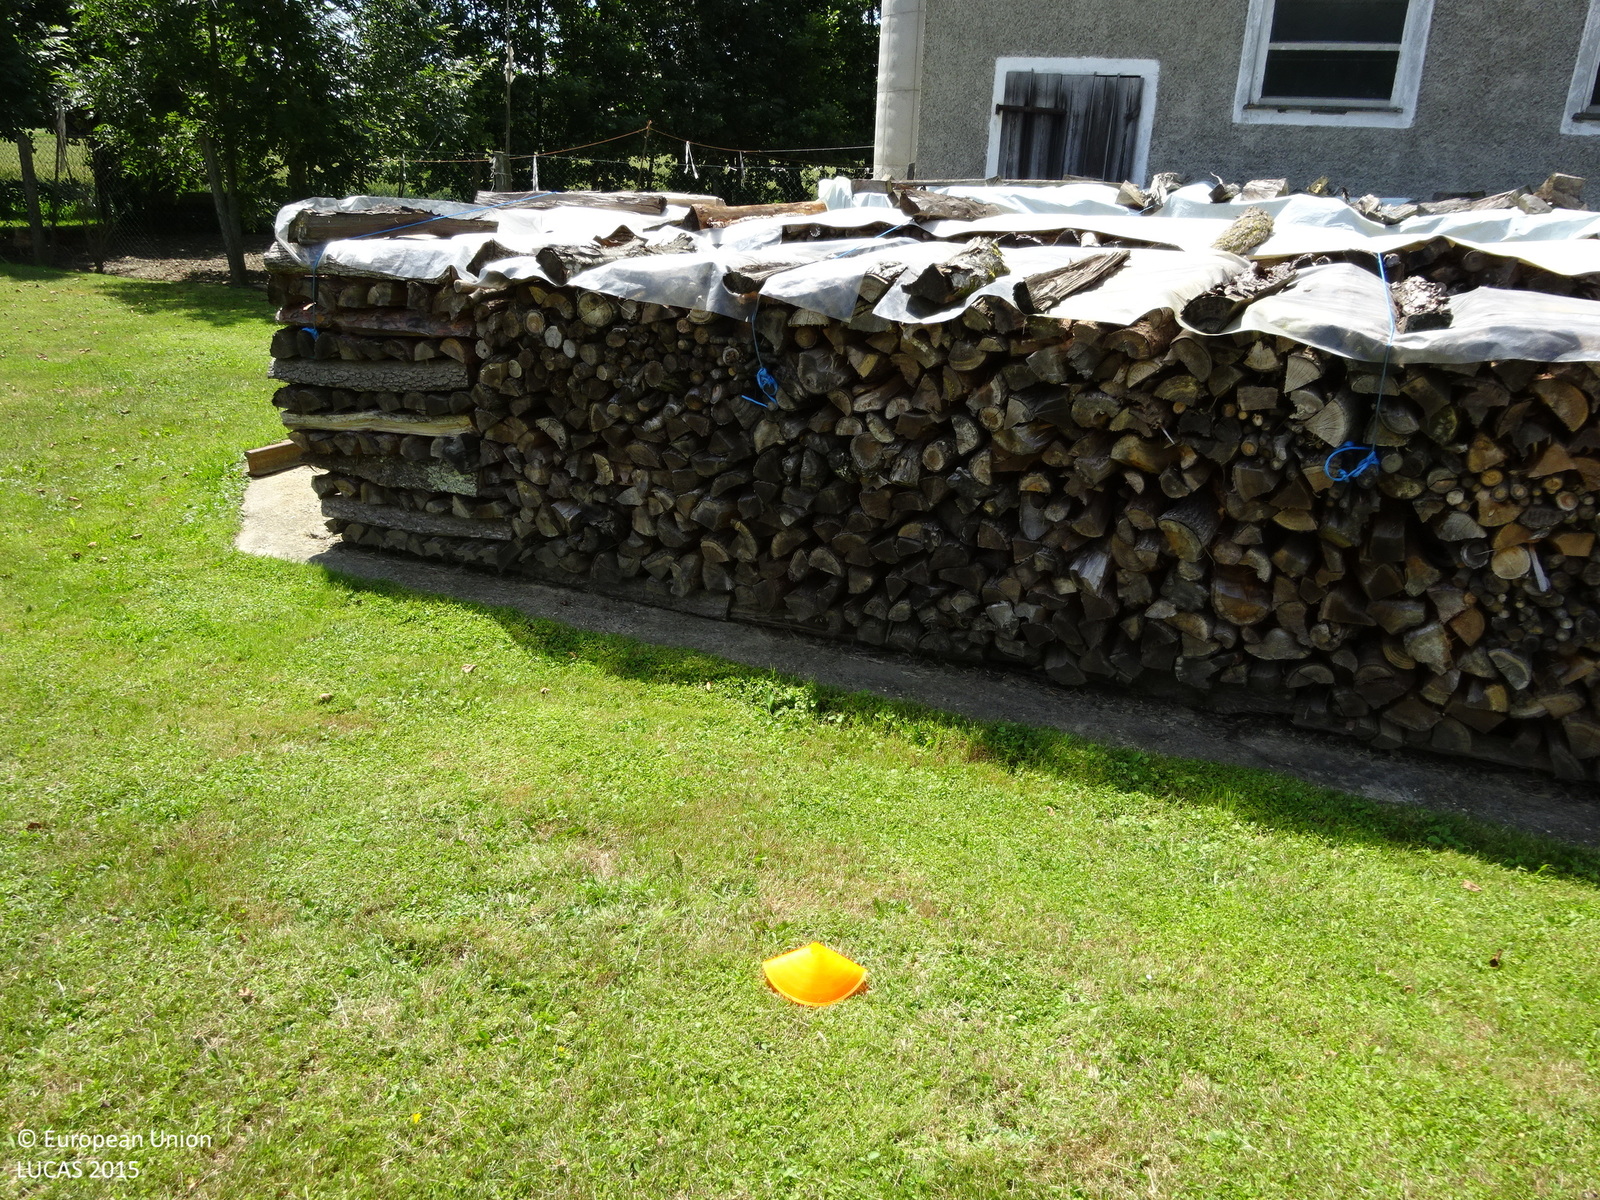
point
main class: Grassland
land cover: Grassland without tree/shrub cover
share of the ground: > 75 %
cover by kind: herbaceous plants 100 %
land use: Agriculture (excluding fallow land and kitchen gardens)
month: June
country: AT
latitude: 46.7644
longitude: 15.9317
